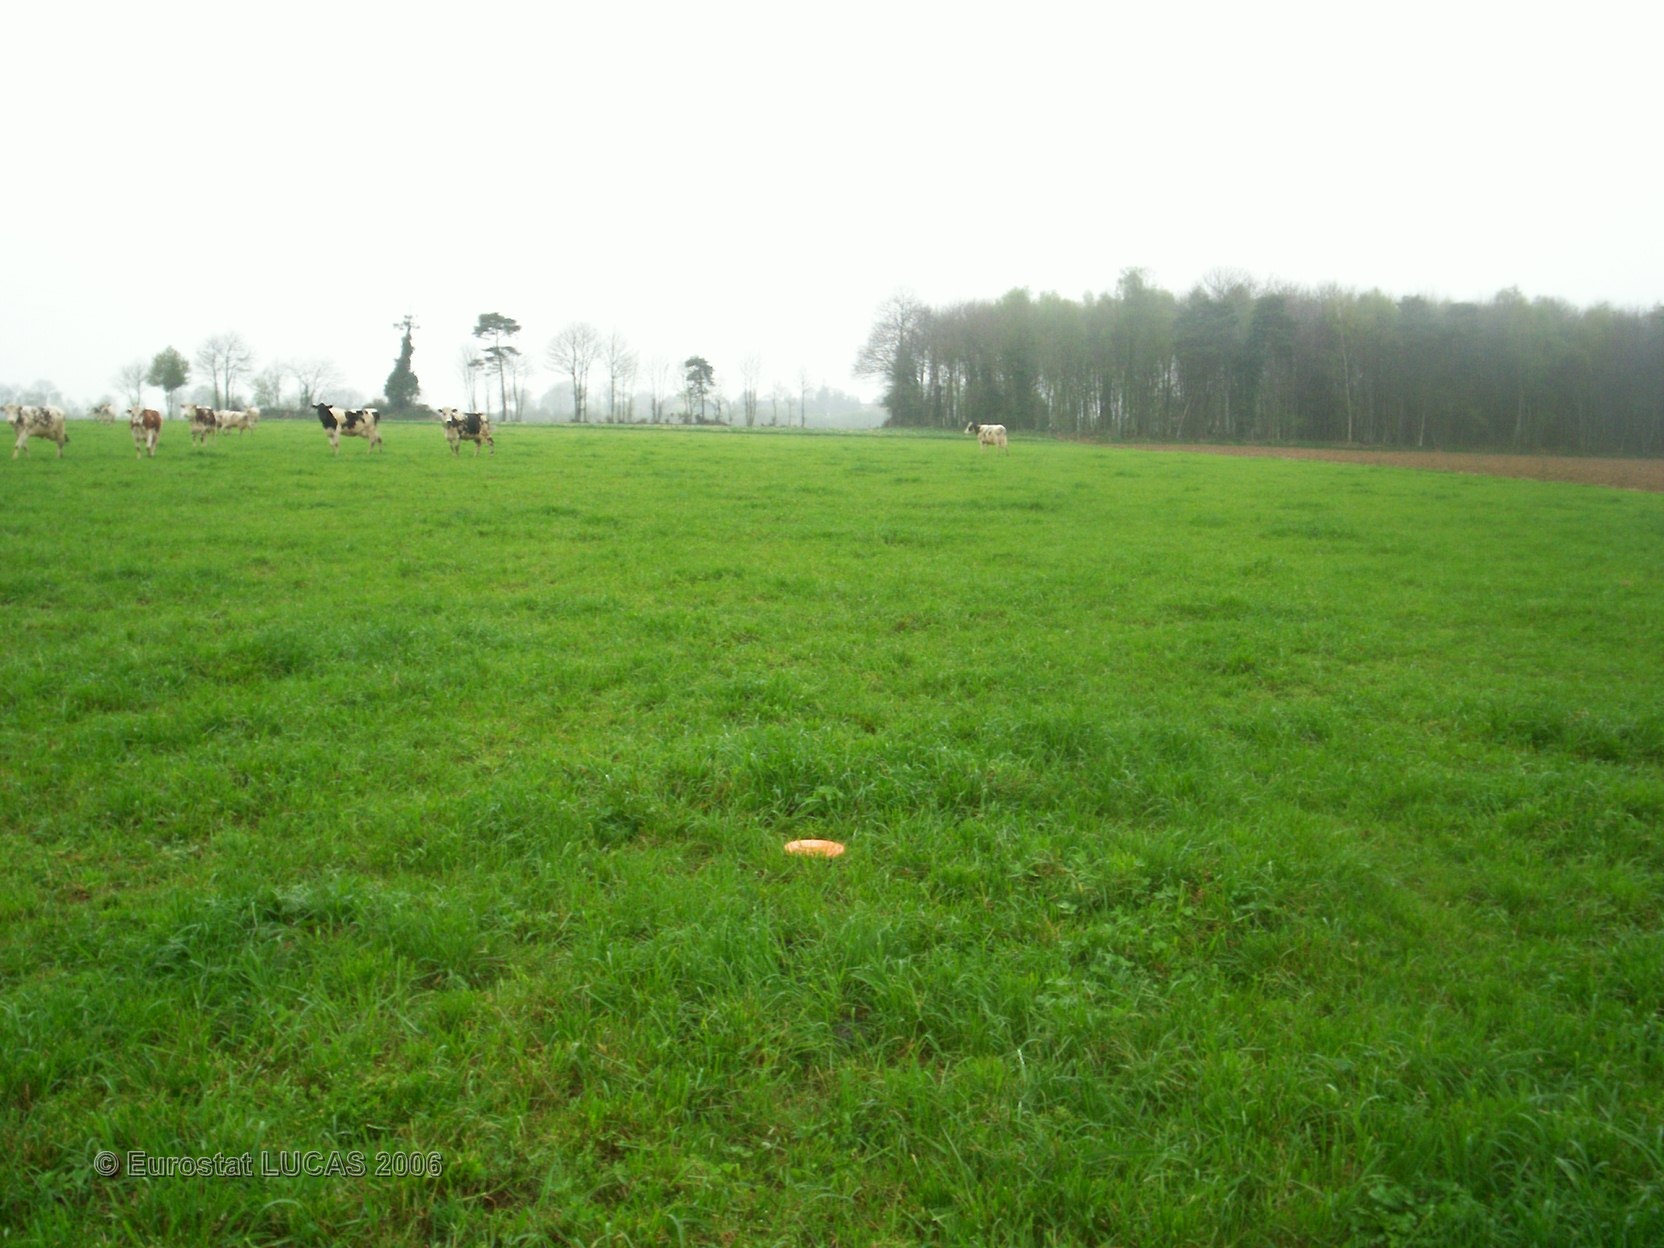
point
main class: Grassland
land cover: Grassland without tree/shrub cover
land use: Agriculture (excluding fallow land and kitchen gardens)
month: April
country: FR
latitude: 48.1382
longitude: -2.4087
